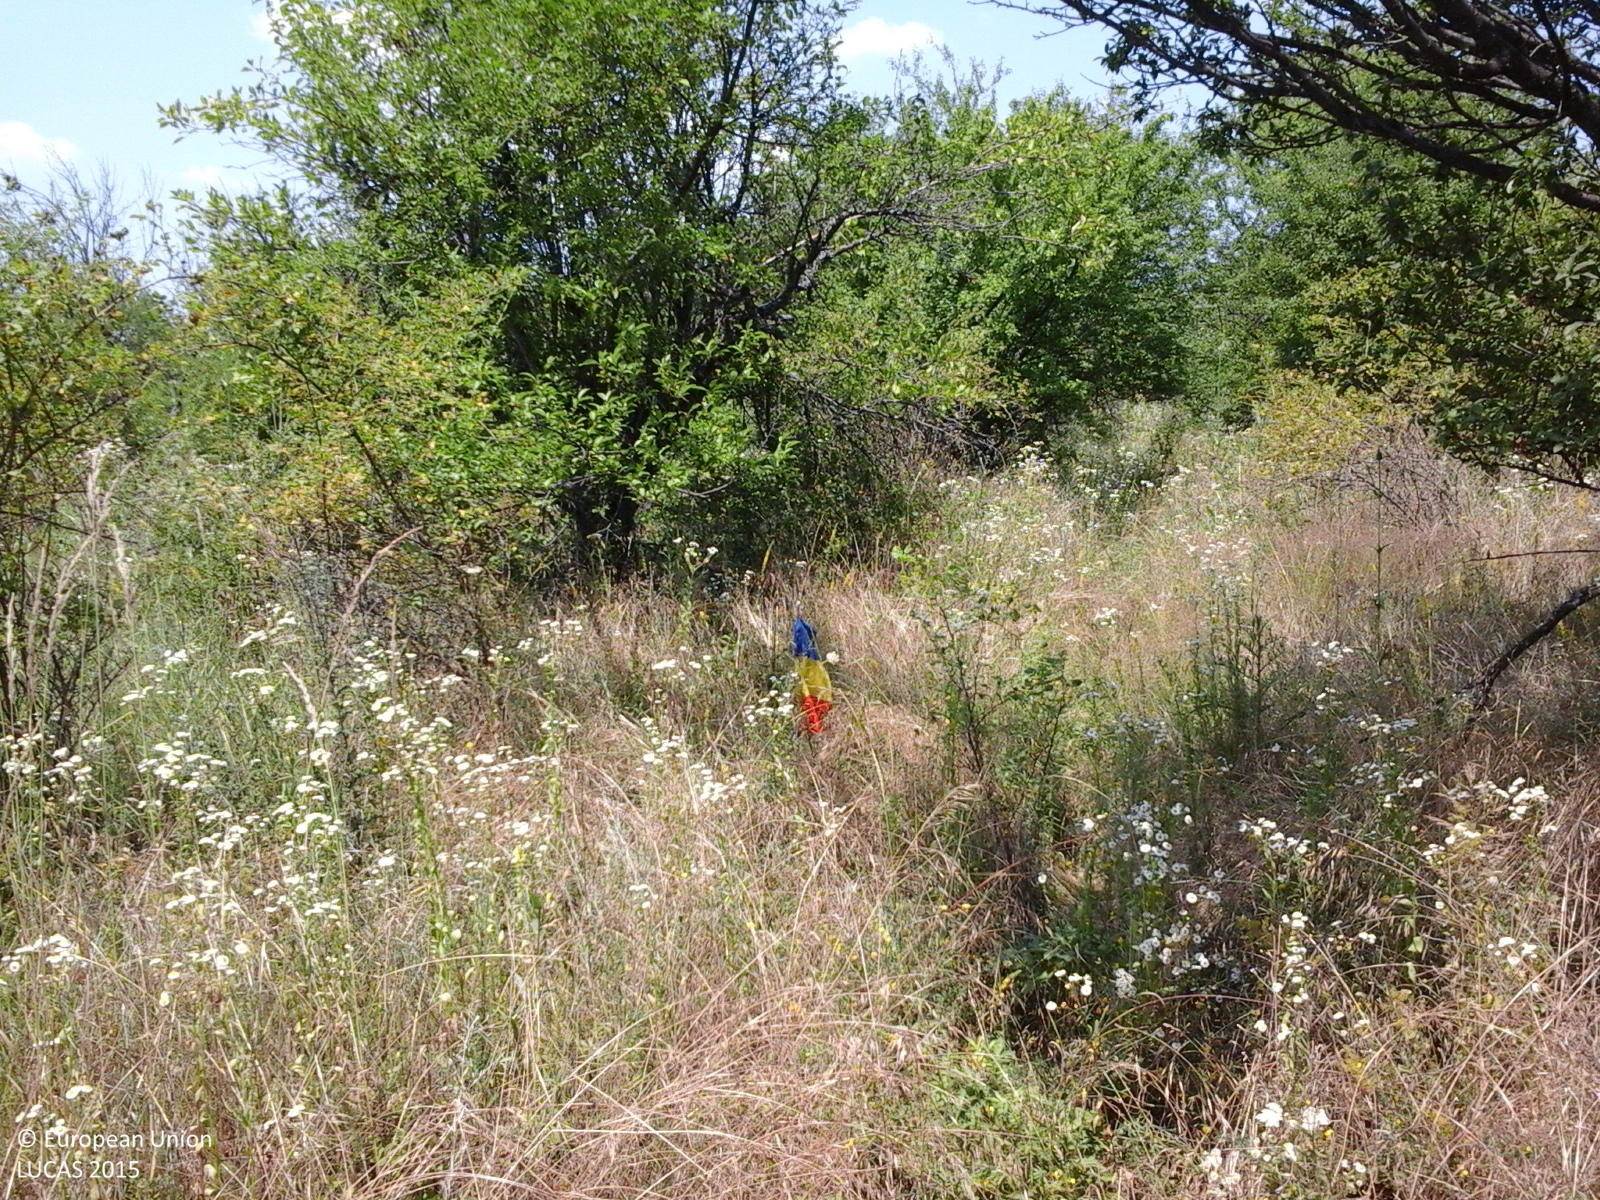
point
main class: Cropland
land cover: Other fruit trees and berries
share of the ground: > 75 %
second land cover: Shrubland without tree cover
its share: 50 - 75 %
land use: Abandoned areas
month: July
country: RO
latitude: 44.7515
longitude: 24.5112
